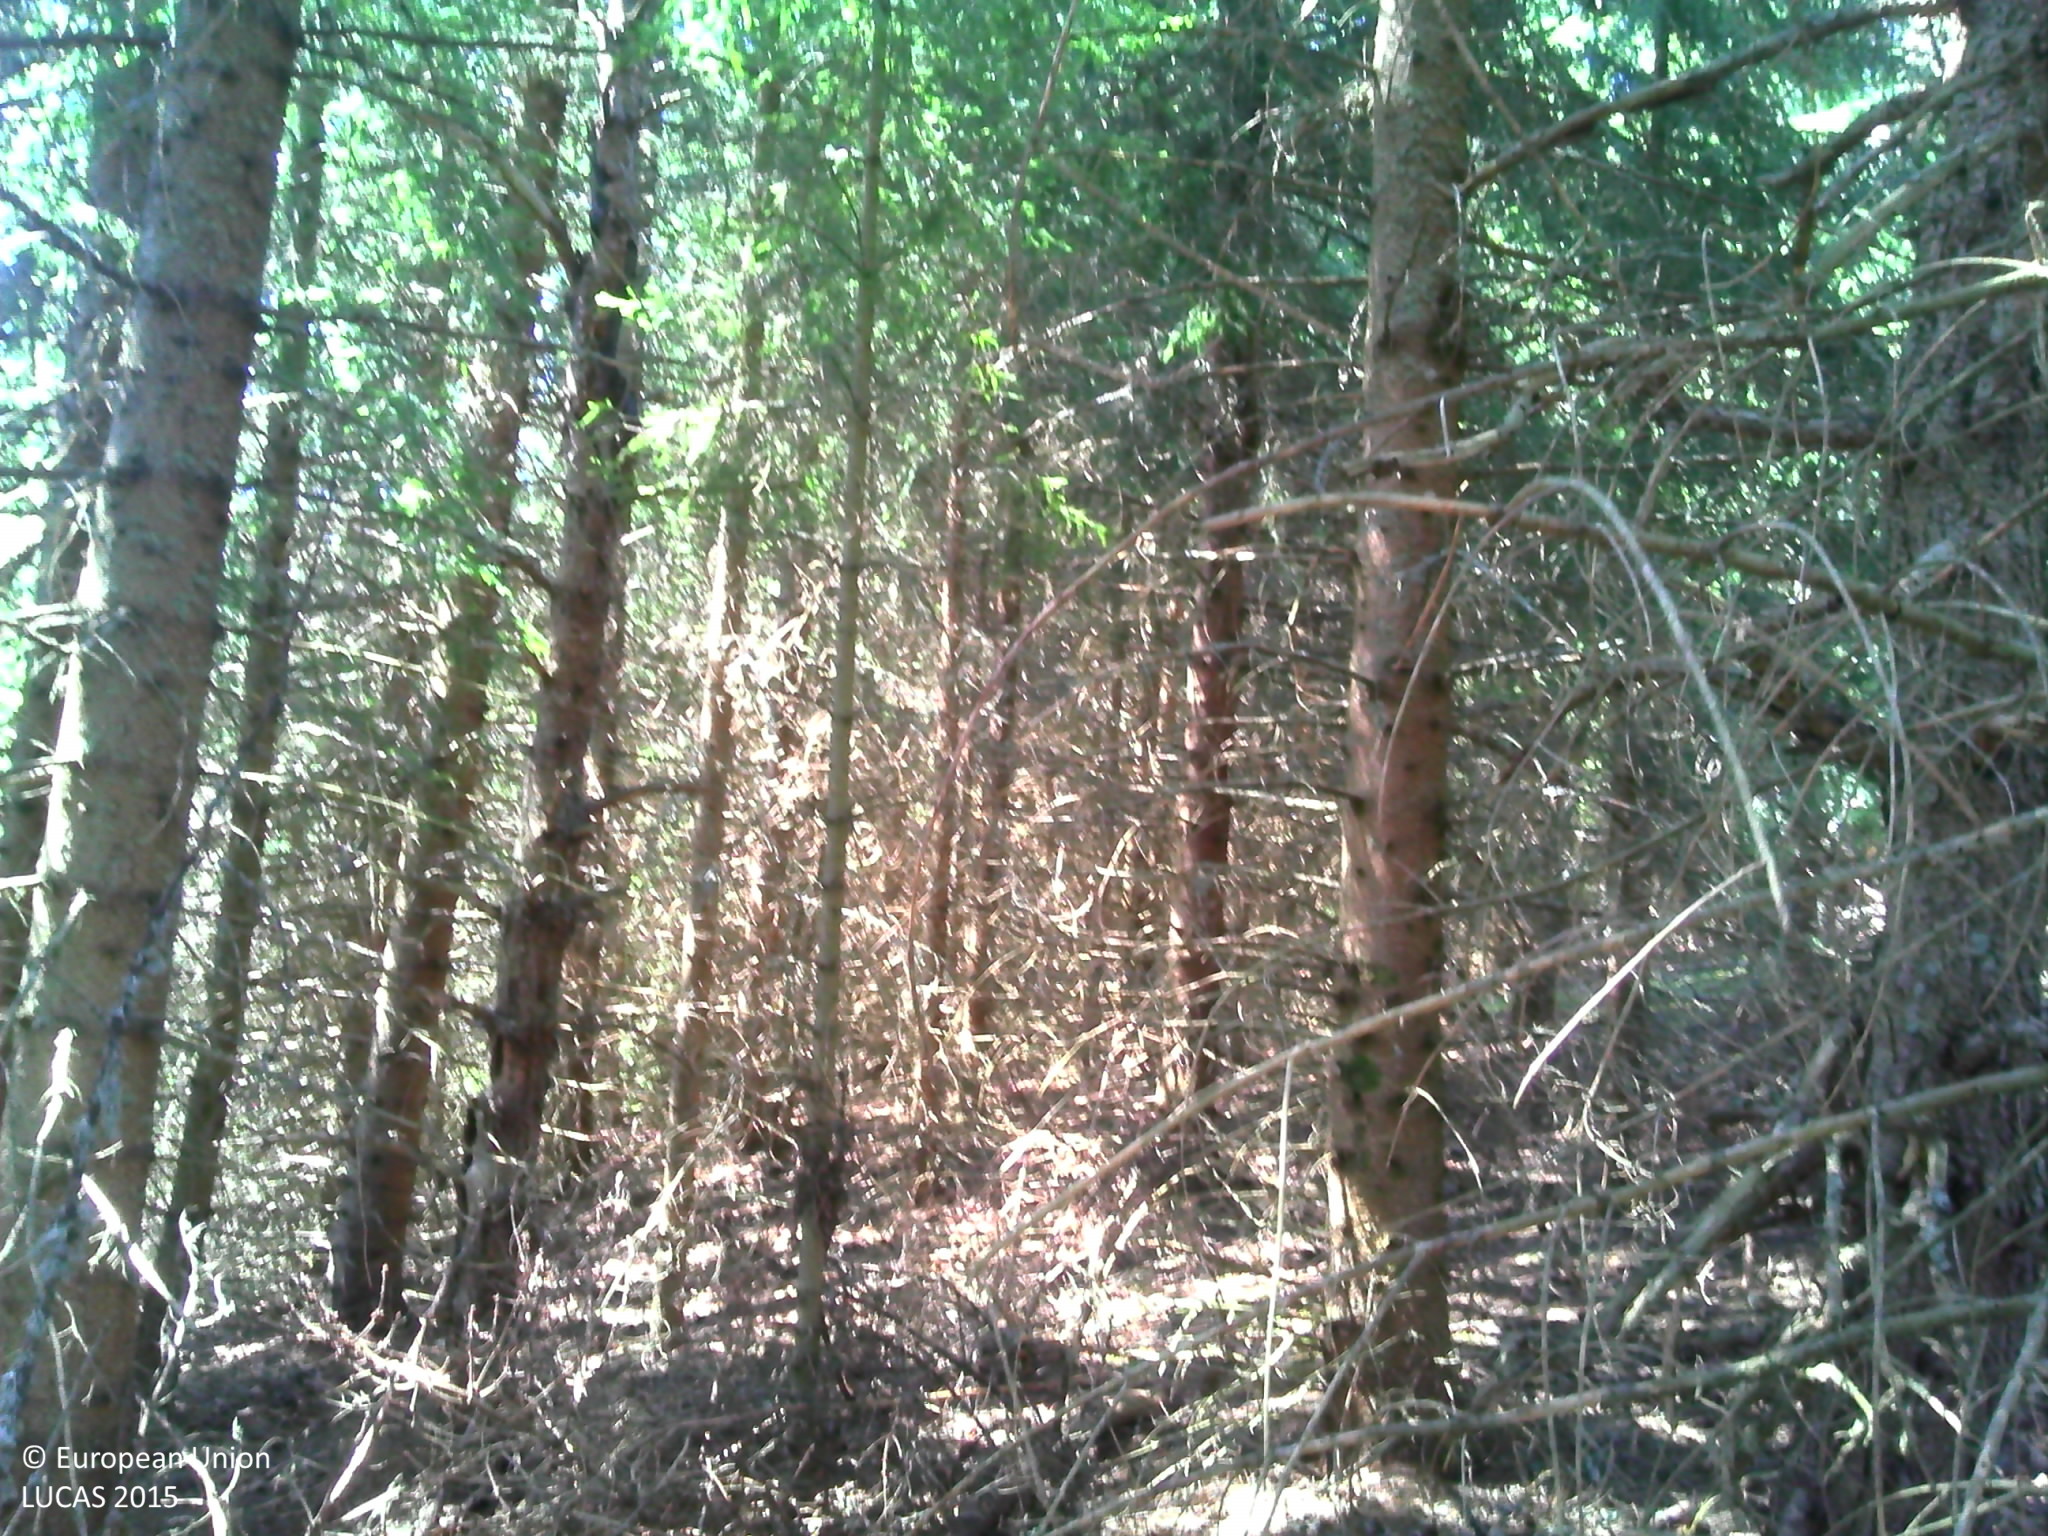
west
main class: Woodland
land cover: Spruce dominated coniferous woodland
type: alpine coniferous forest
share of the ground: > 75 %
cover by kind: coniferous forest trees 95 %, broadleaved forest trees 5 %
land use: Forestry
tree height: > 5 m
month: August
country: FR
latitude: 44.7990
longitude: 3.5190
